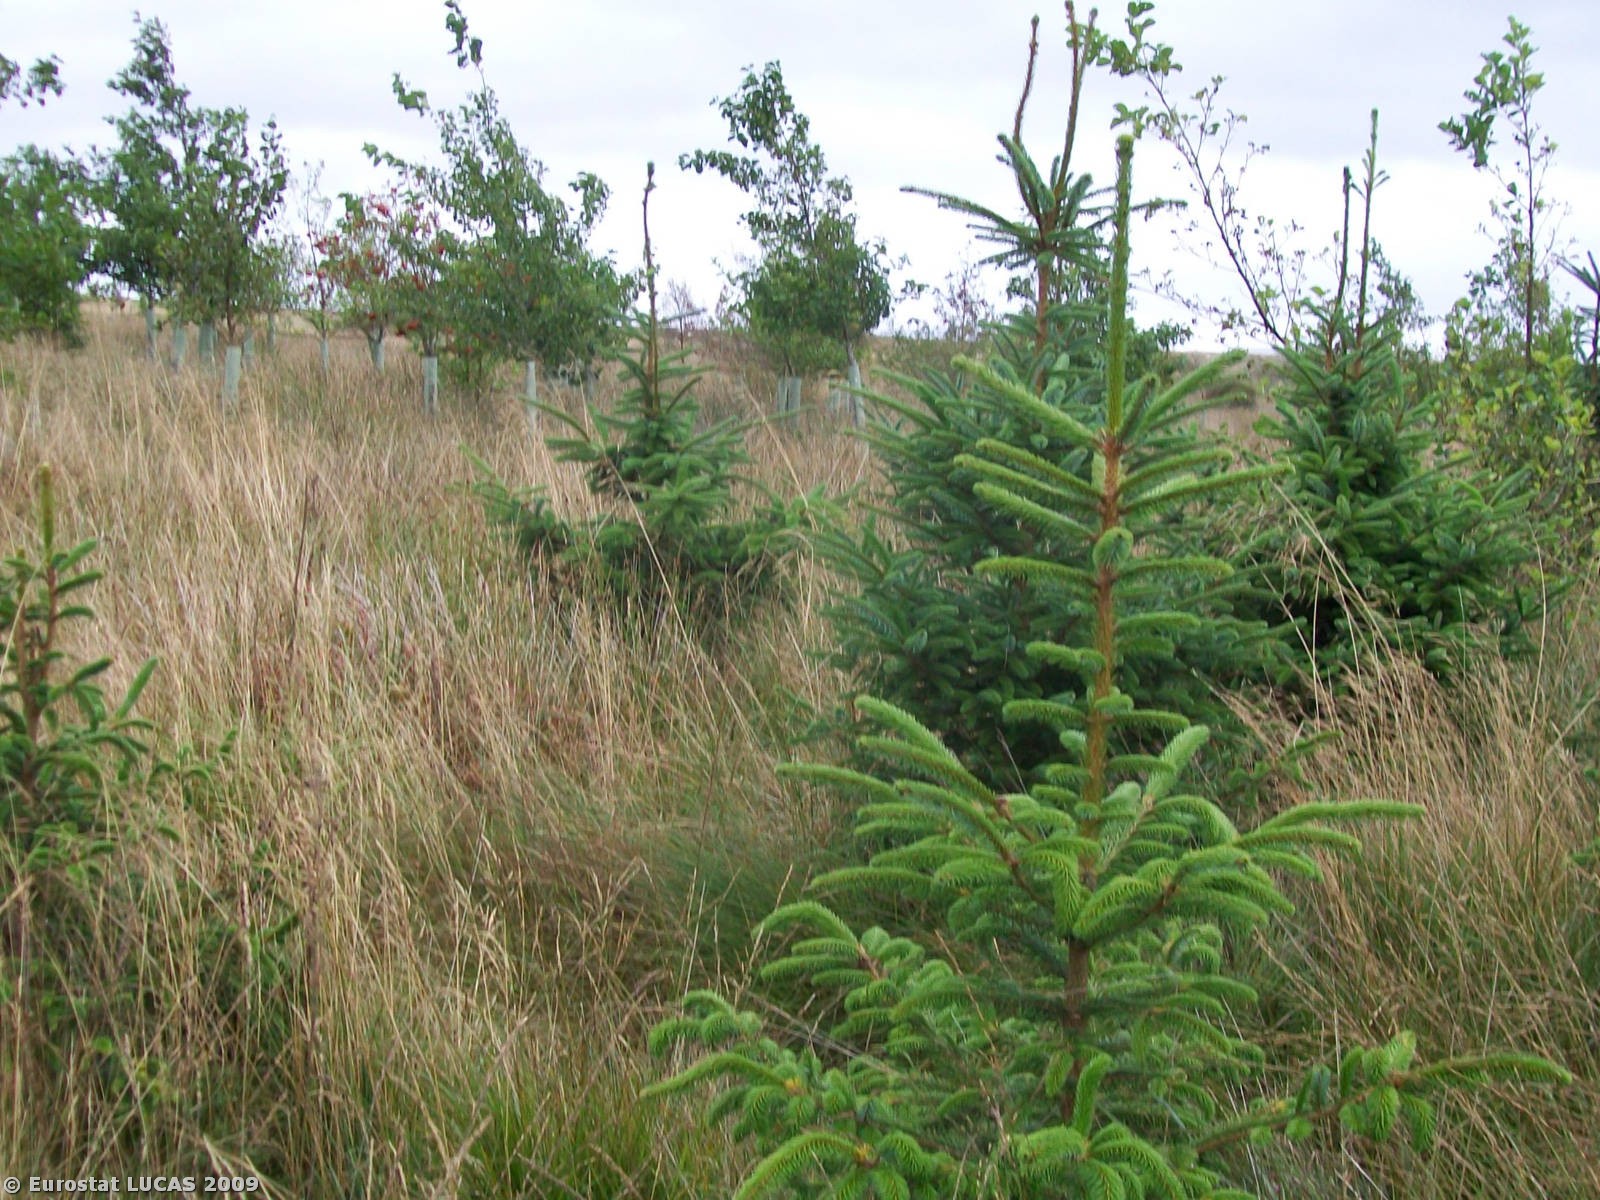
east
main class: Woodland
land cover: Mixed woodland
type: hemiboreal forest and nemoral coniferous forest and mixed broadleaved-coniferous forest
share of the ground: 25 - 50 %
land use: Forestry
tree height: > 5 m
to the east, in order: Mixed woodland; Grassland without tree/shrub cover; Abandoned hedges; Ditches and canals; Abandoned hedges; Grassland without tree/shrub cover; Ditches and canals; Grass margins; Fences; Grass margins; Tracks; Grass margins; Fences; Grassland without tree/shrub cover; Ditches and canals; Grassland without tree/shrub cover; Fences; Grassland without tree/shrub cover
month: September
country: GB
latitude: 55.4952
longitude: -4.2615
